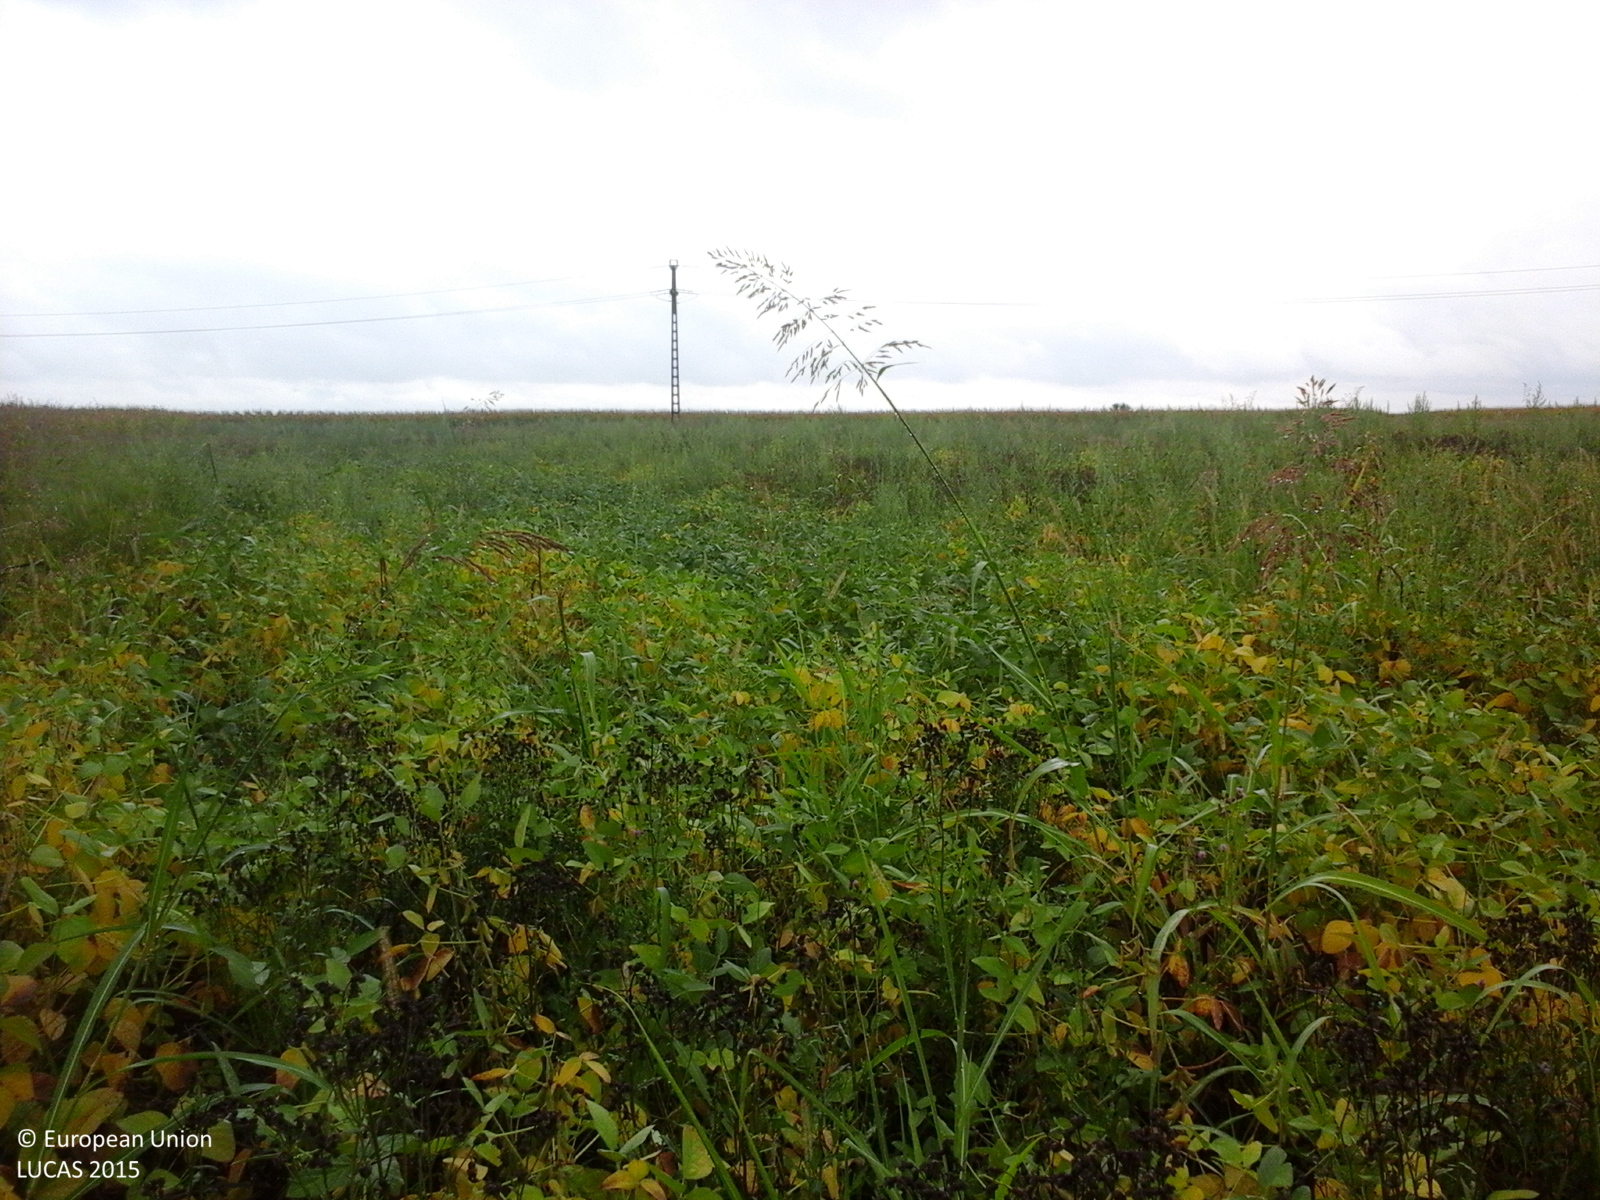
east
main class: Cropland
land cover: Maize
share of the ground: > 75 %
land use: Agriculture (excluding fallow land and kitchen gardens)
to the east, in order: Maize; Electric lines; Maize; Grass margins; Tracks; Grass margins; Maize
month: August
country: RO
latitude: 45.9356
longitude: 20.7441
